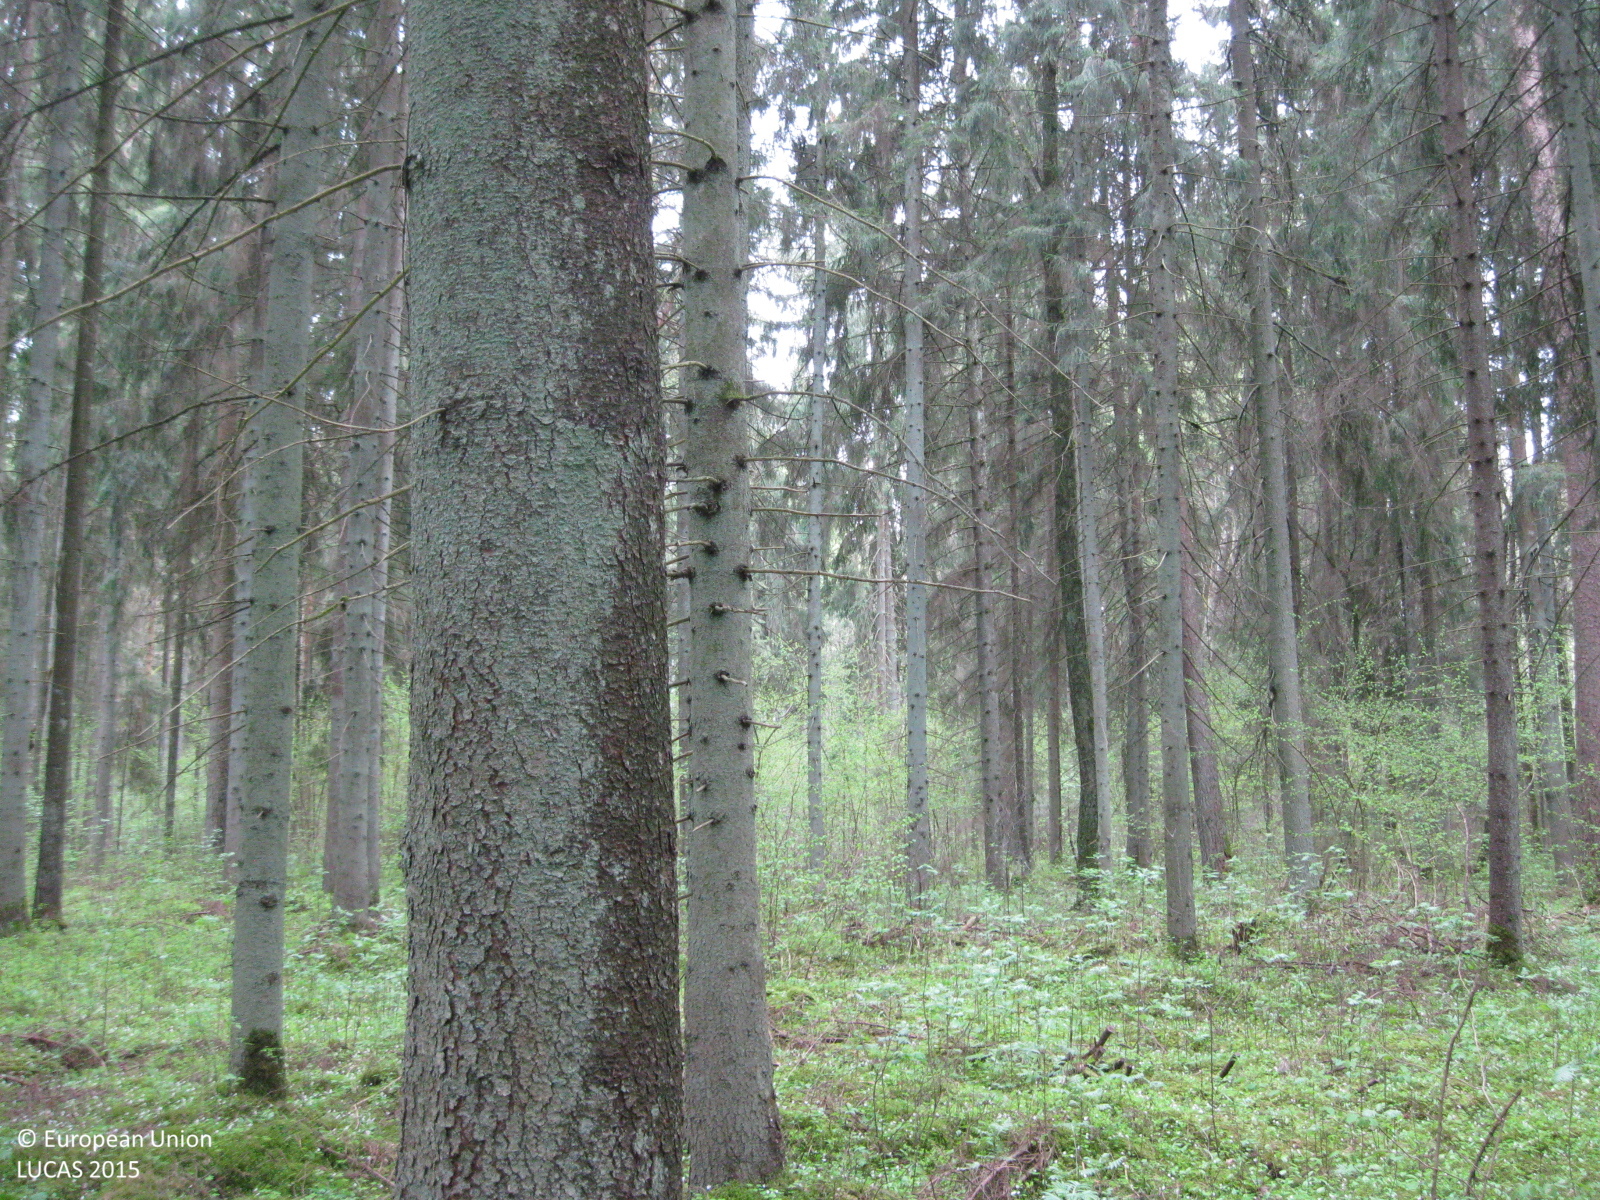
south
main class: Woodland
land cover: Spruce dominated coniferous woodland
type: hemiboreal forest and nemoral coniferous forest and mixed broadleaved-coniferous forest
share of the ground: > 75 %
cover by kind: coniferous forest trees 75 %, lichens and mosses 10 %, broadleaved forest trees 5 %, shrubs 5 %, herbaceous plants 5 %
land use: Forestry
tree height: > 5 m
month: May
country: LT
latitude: 56.1519
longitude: 24.4395
